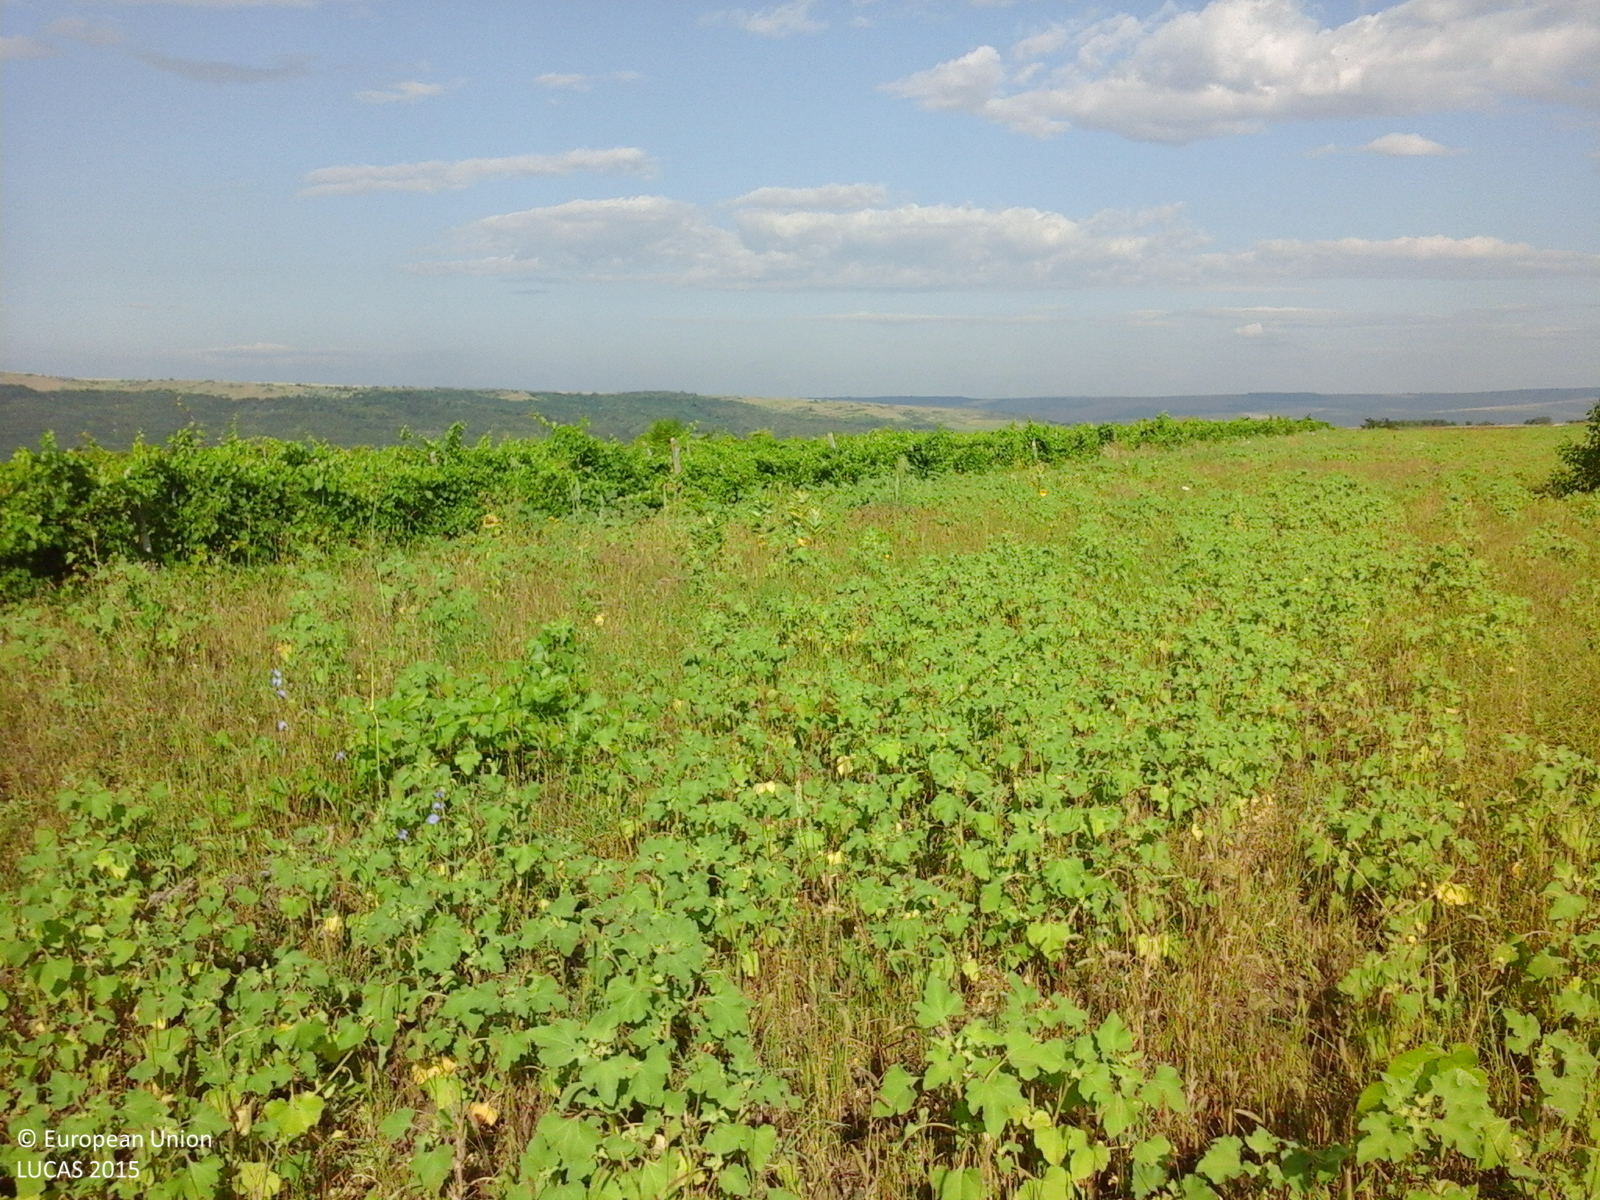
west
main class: Grassland
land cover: Spontaneously vegetated surfaces
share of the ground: > 75 %
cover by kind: herbaceous plants 100 %
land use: Abandoned areas
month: July
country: RO
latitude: 46.1521
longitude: 27.6839
